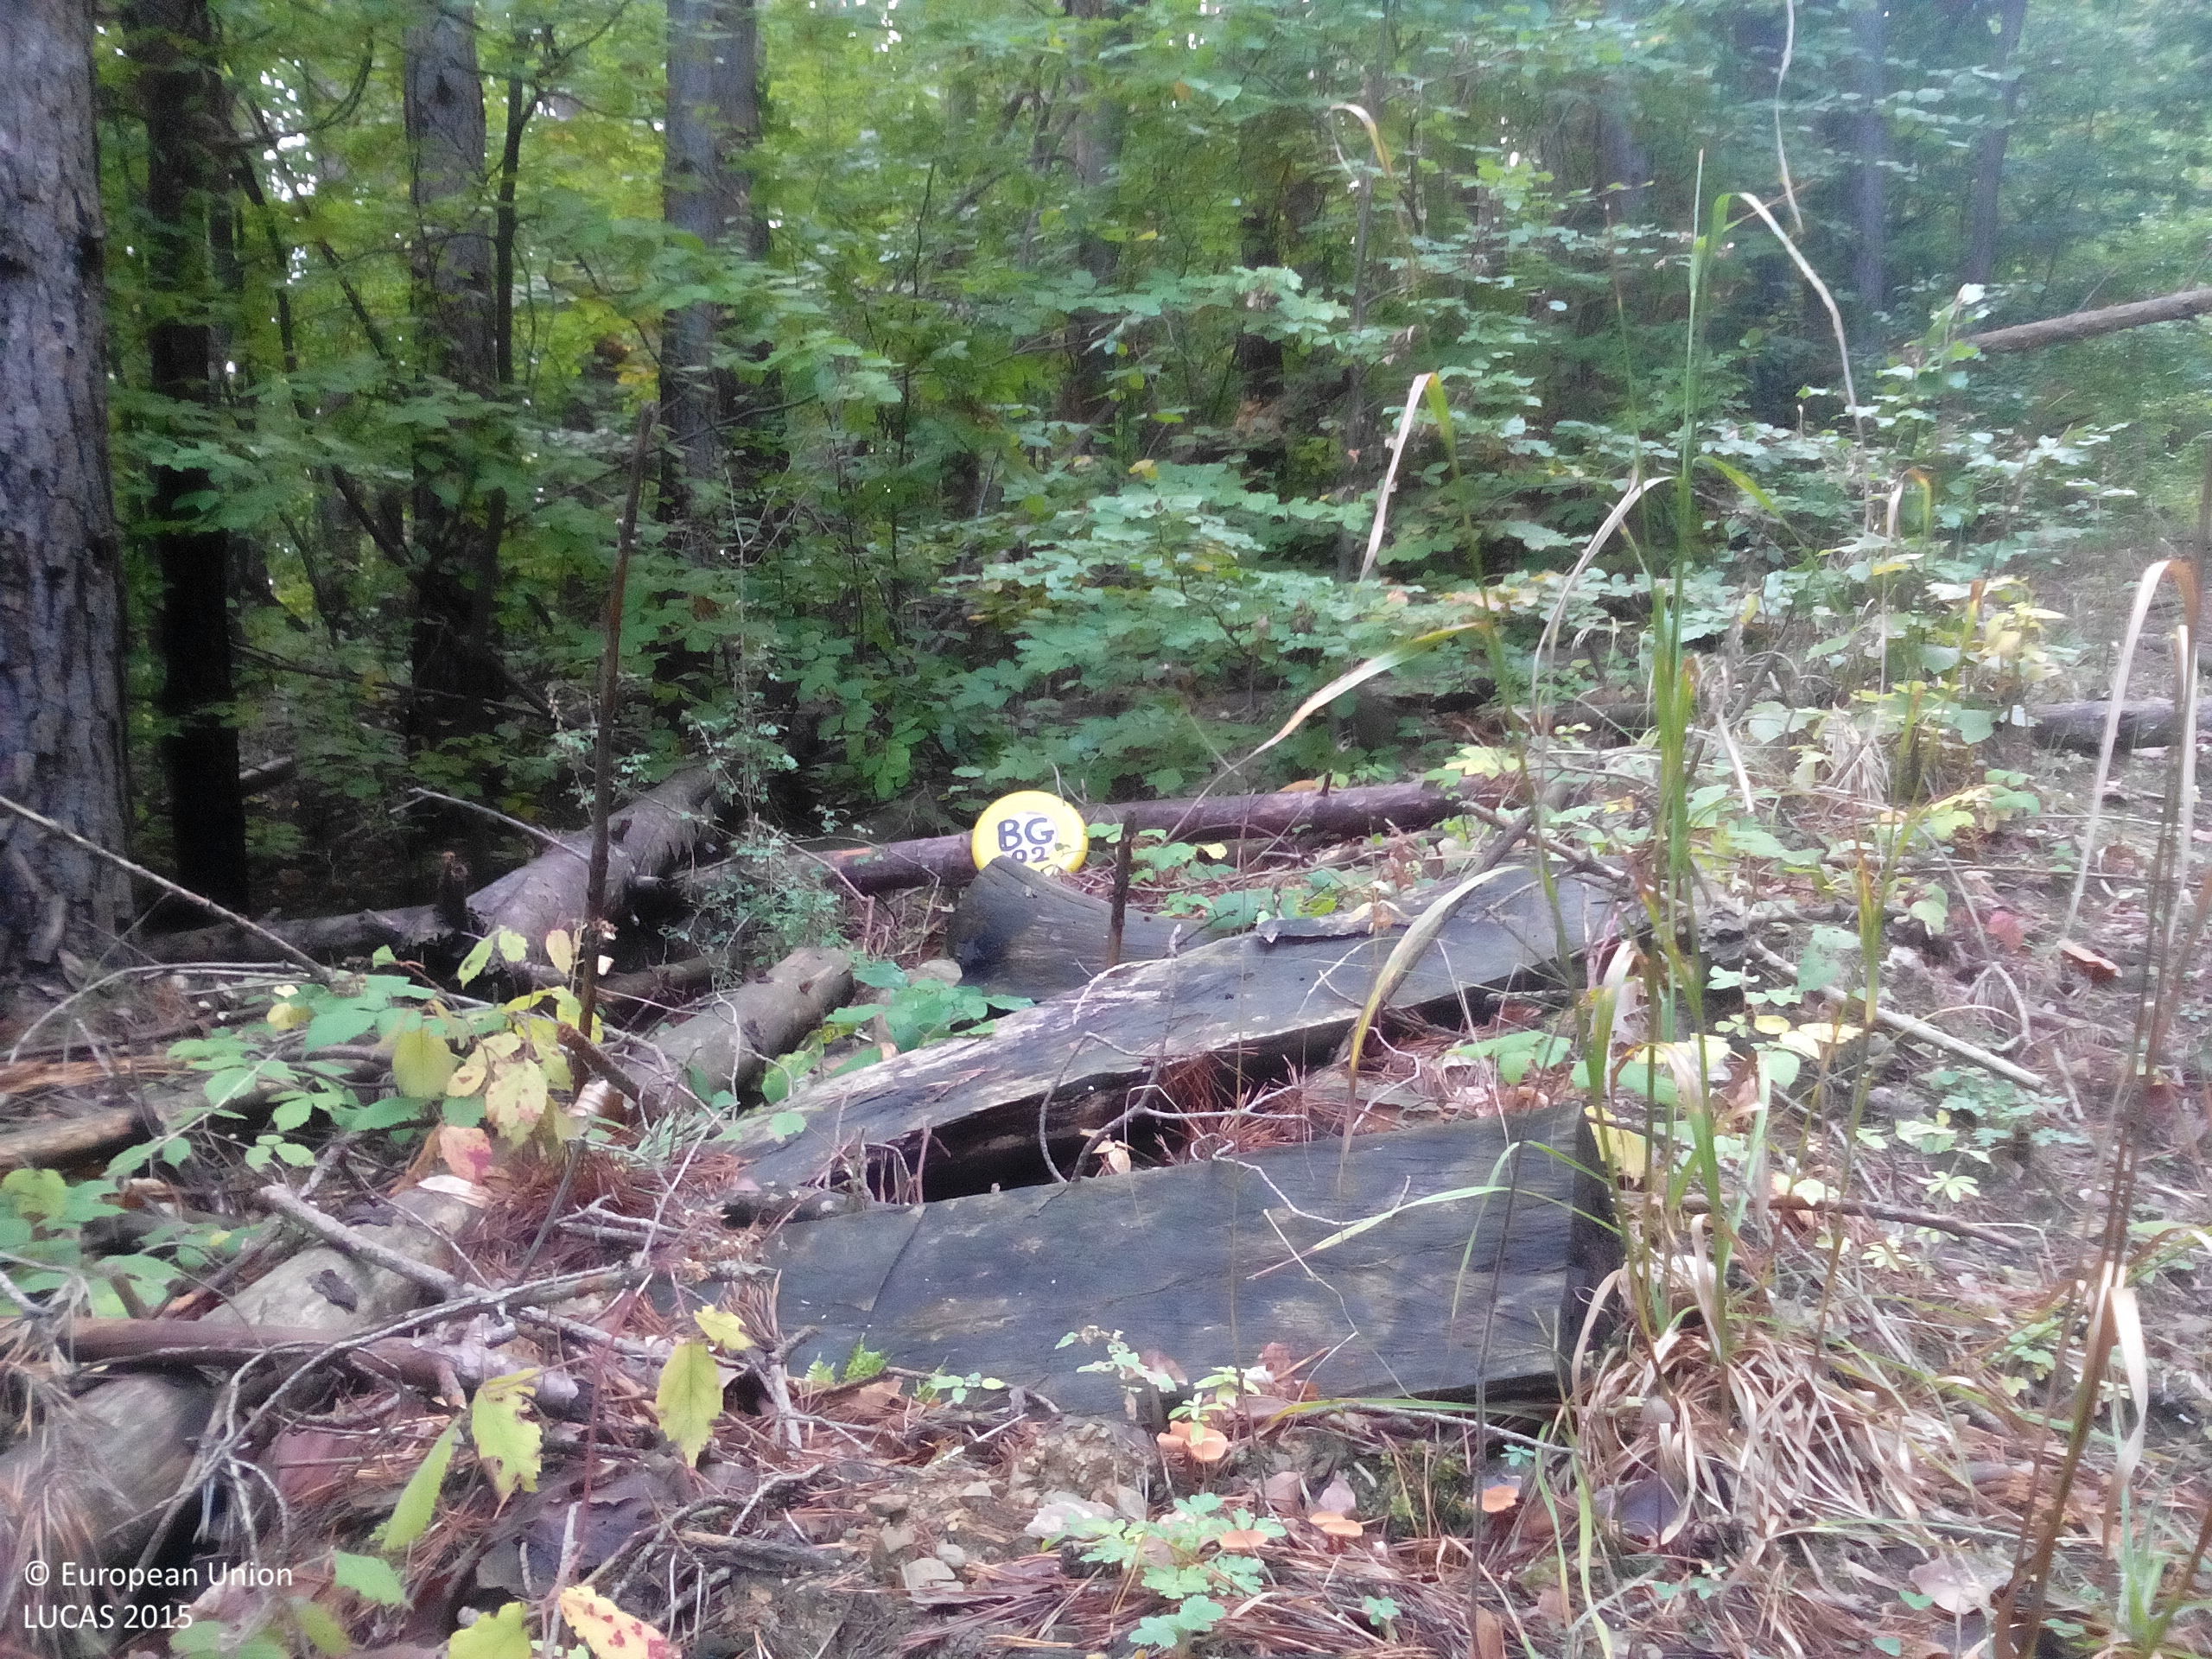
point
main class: Woodland
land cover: Pine dominated mixed woodland
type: alpine coniferous forest
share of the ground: 50 - 75 %
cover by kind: coniferous forest trees 70 %, broadleaved forest trees 25 %, shrubs 5 %
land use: Forestry
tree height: > 5 m
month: October
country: BG
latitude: 42.8444
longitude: 24.2813
